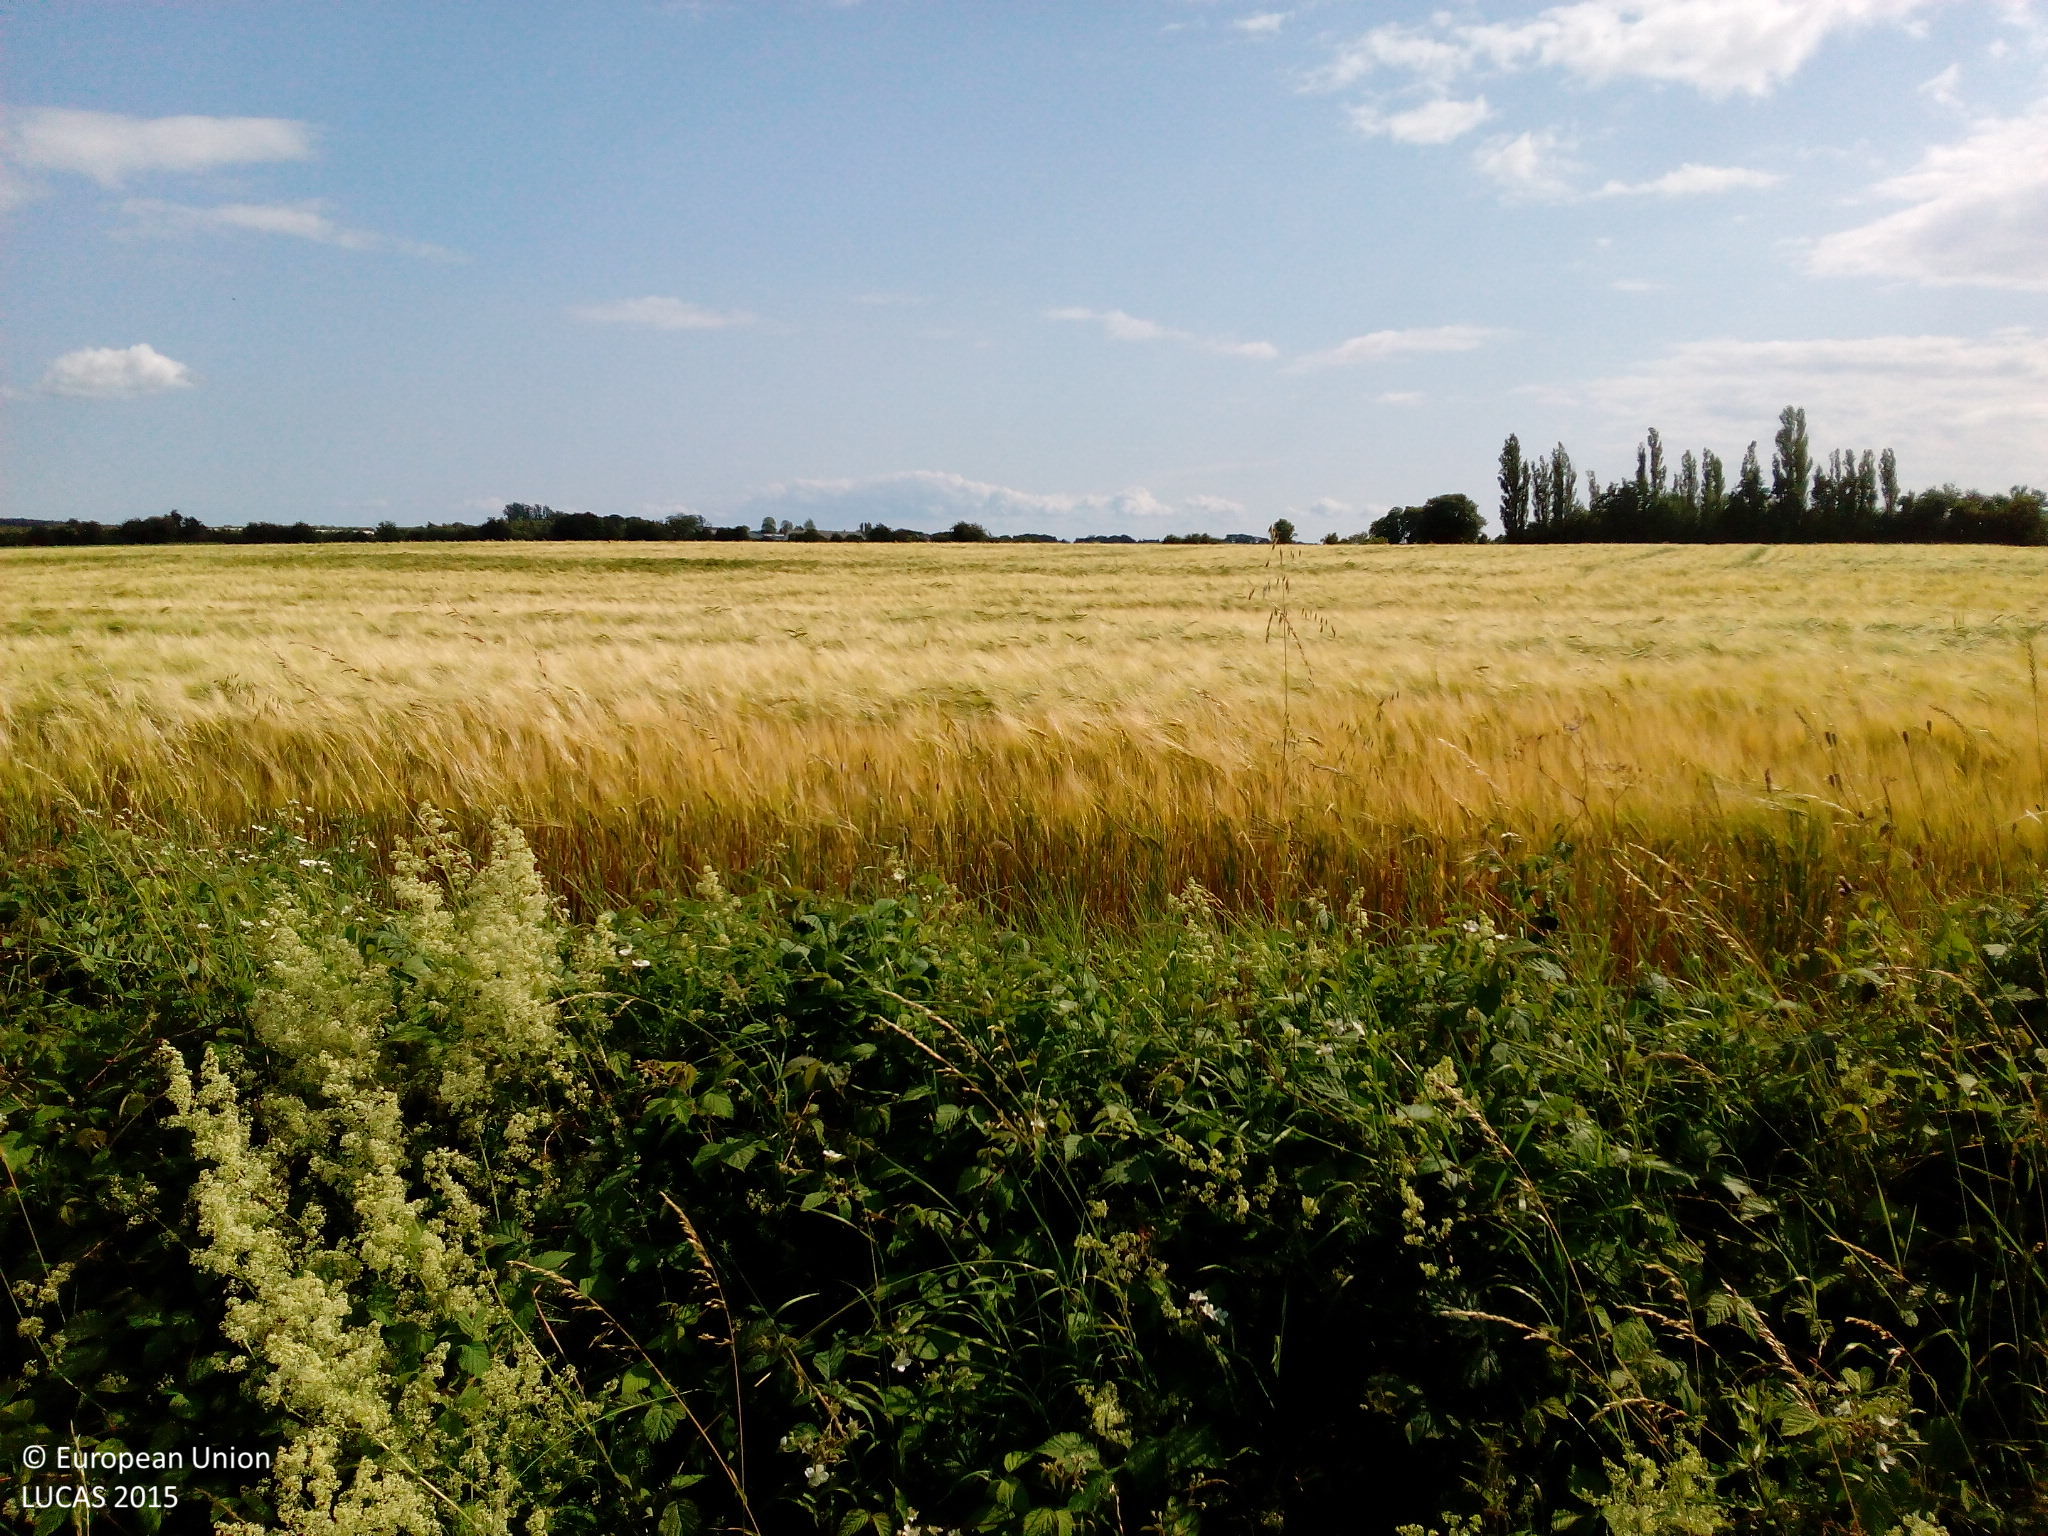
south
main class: Cropland
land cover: Barley
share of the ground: > 75 %
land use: Agriculture (excluding fallow land and kitchen gardens)
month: July
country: DK
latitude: 55.3006
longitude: 11.2748
